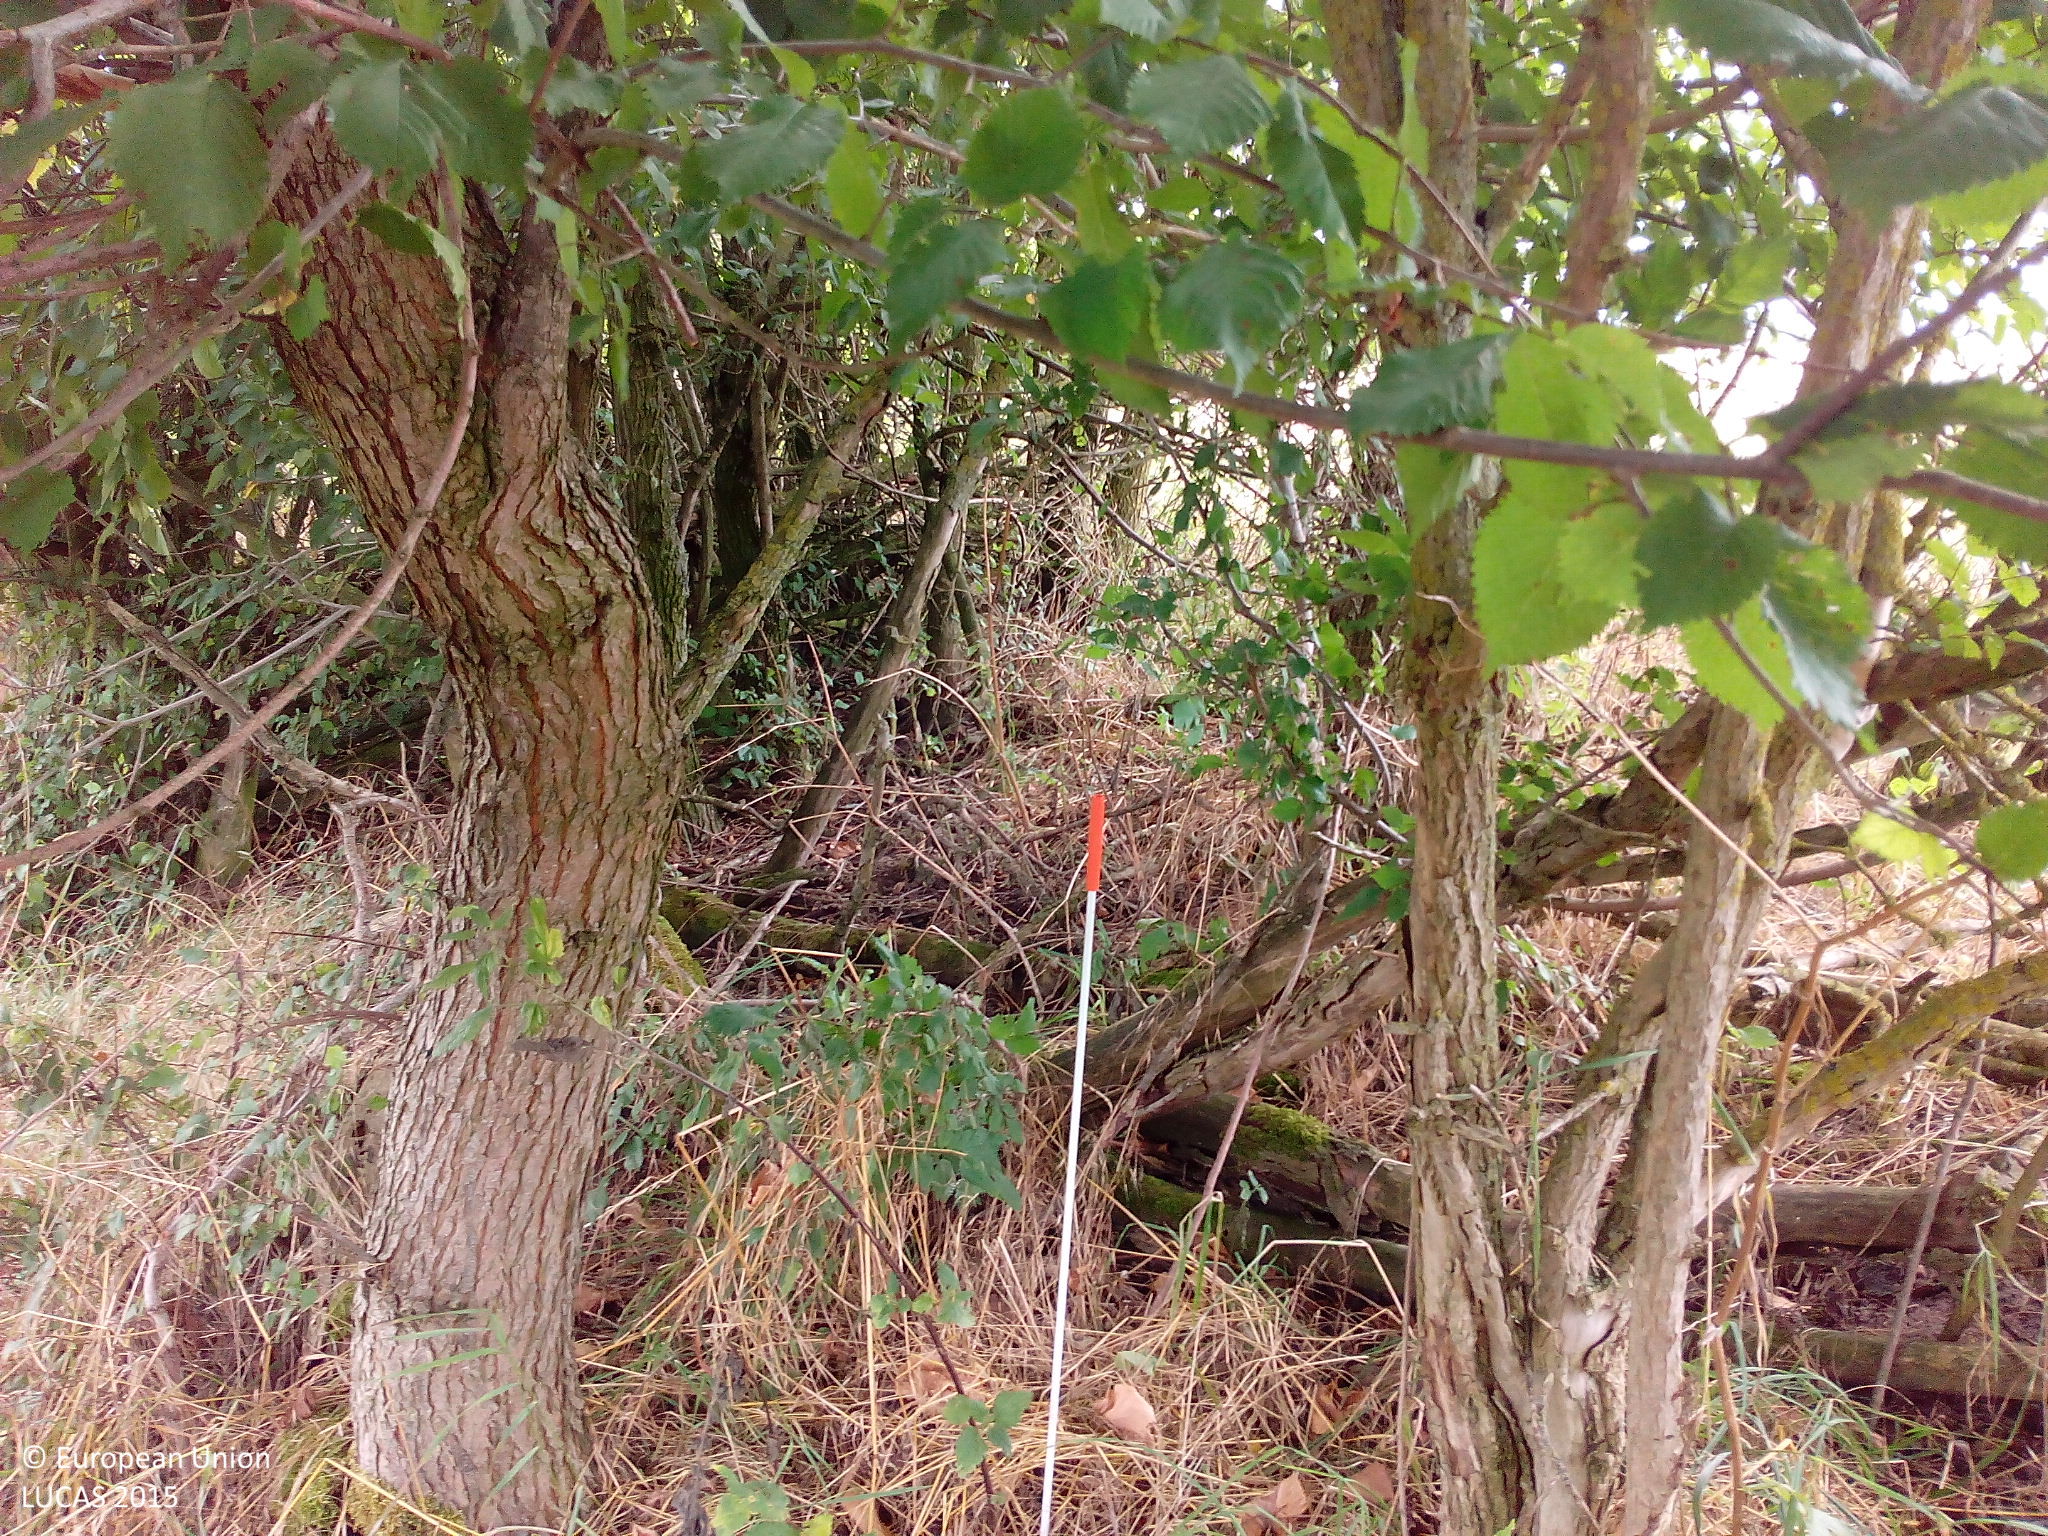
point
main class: Woodland
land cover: Broadleaved woodland
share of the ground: 50 - 75 %
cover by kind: herbaceous plants 80 %, broadleaved forest trees 10 %, unconsolidated bare surface 10 %
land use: Semi-natural and natural areas not in use
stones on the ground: < 10 %
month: August
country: DE
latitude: 53.9135
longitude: 12.6025
